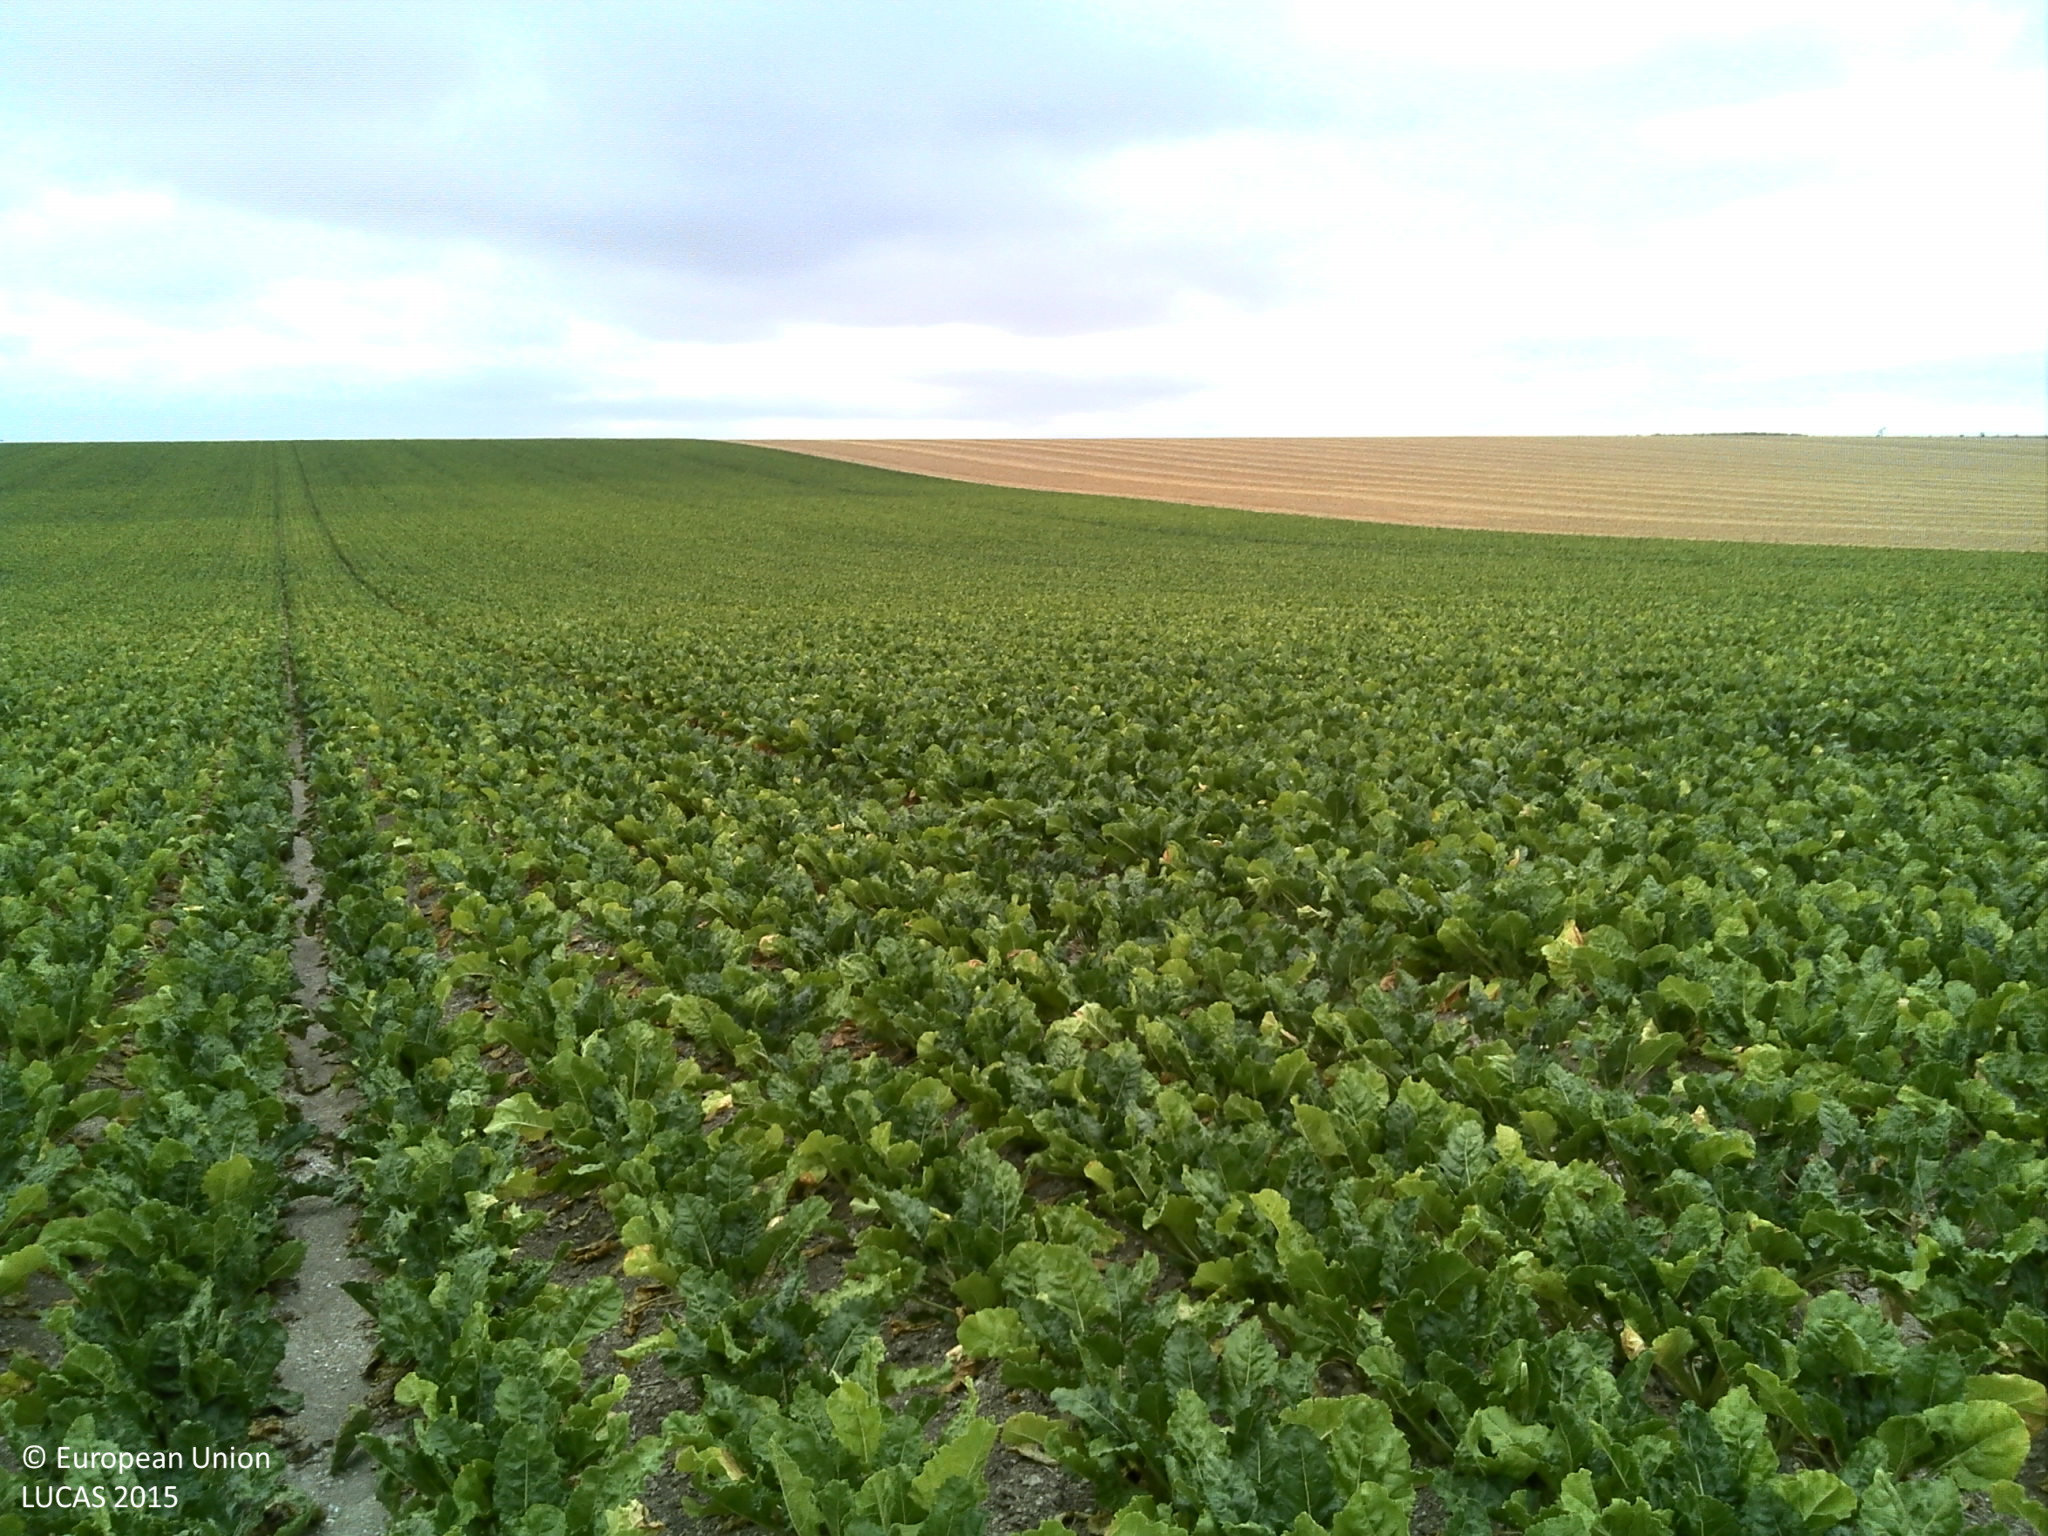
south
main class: Cropland
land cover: Sugar beet
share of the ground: 50 - 75 %
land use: Agriculture (excluding fallow land and kitchen gardens)
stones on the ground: < 10 %
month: August
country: FR
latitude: 48.7764
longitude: 4.2400
